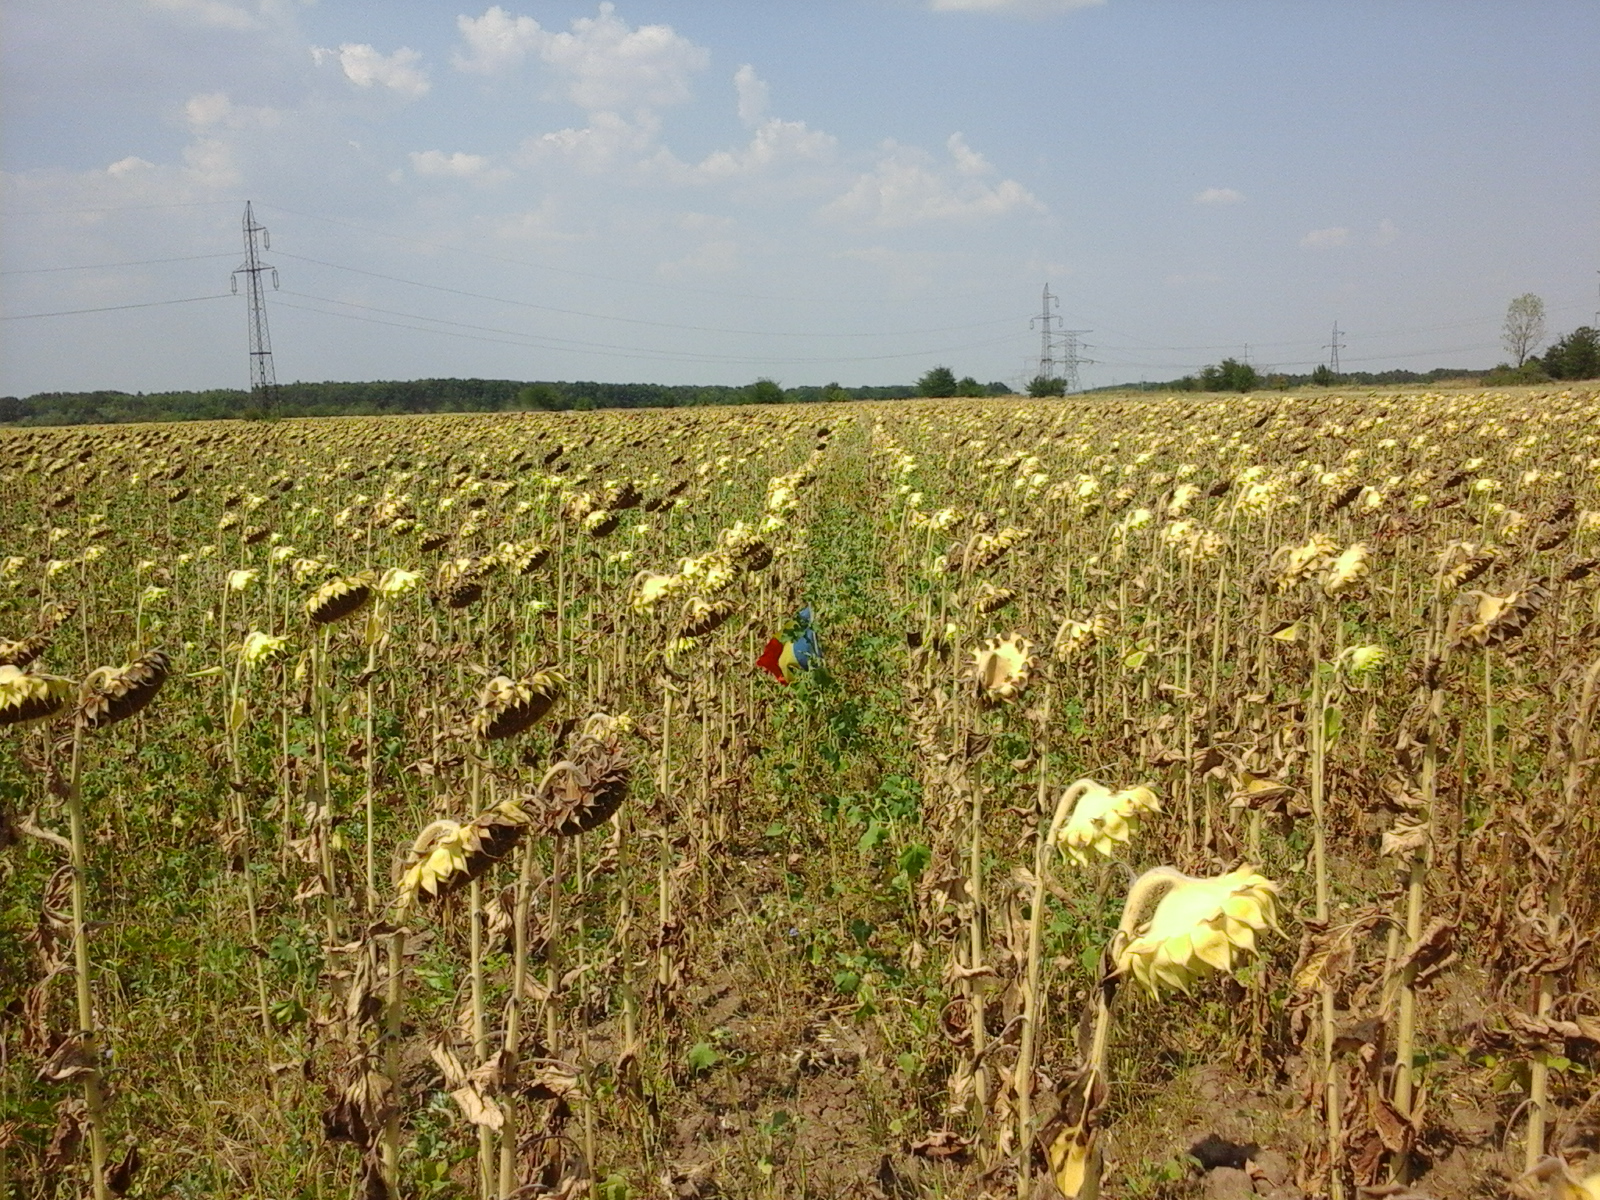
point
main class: Cropland
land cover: Sunflower
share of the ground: 50 - 75 %
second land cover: Spontaneously vegetated surfaces
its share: 25 - 50 %
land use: Agriculture (excluding fallow land and kitchen gardens)
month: August
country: RO
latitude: 44.1733
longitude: 23.5213
